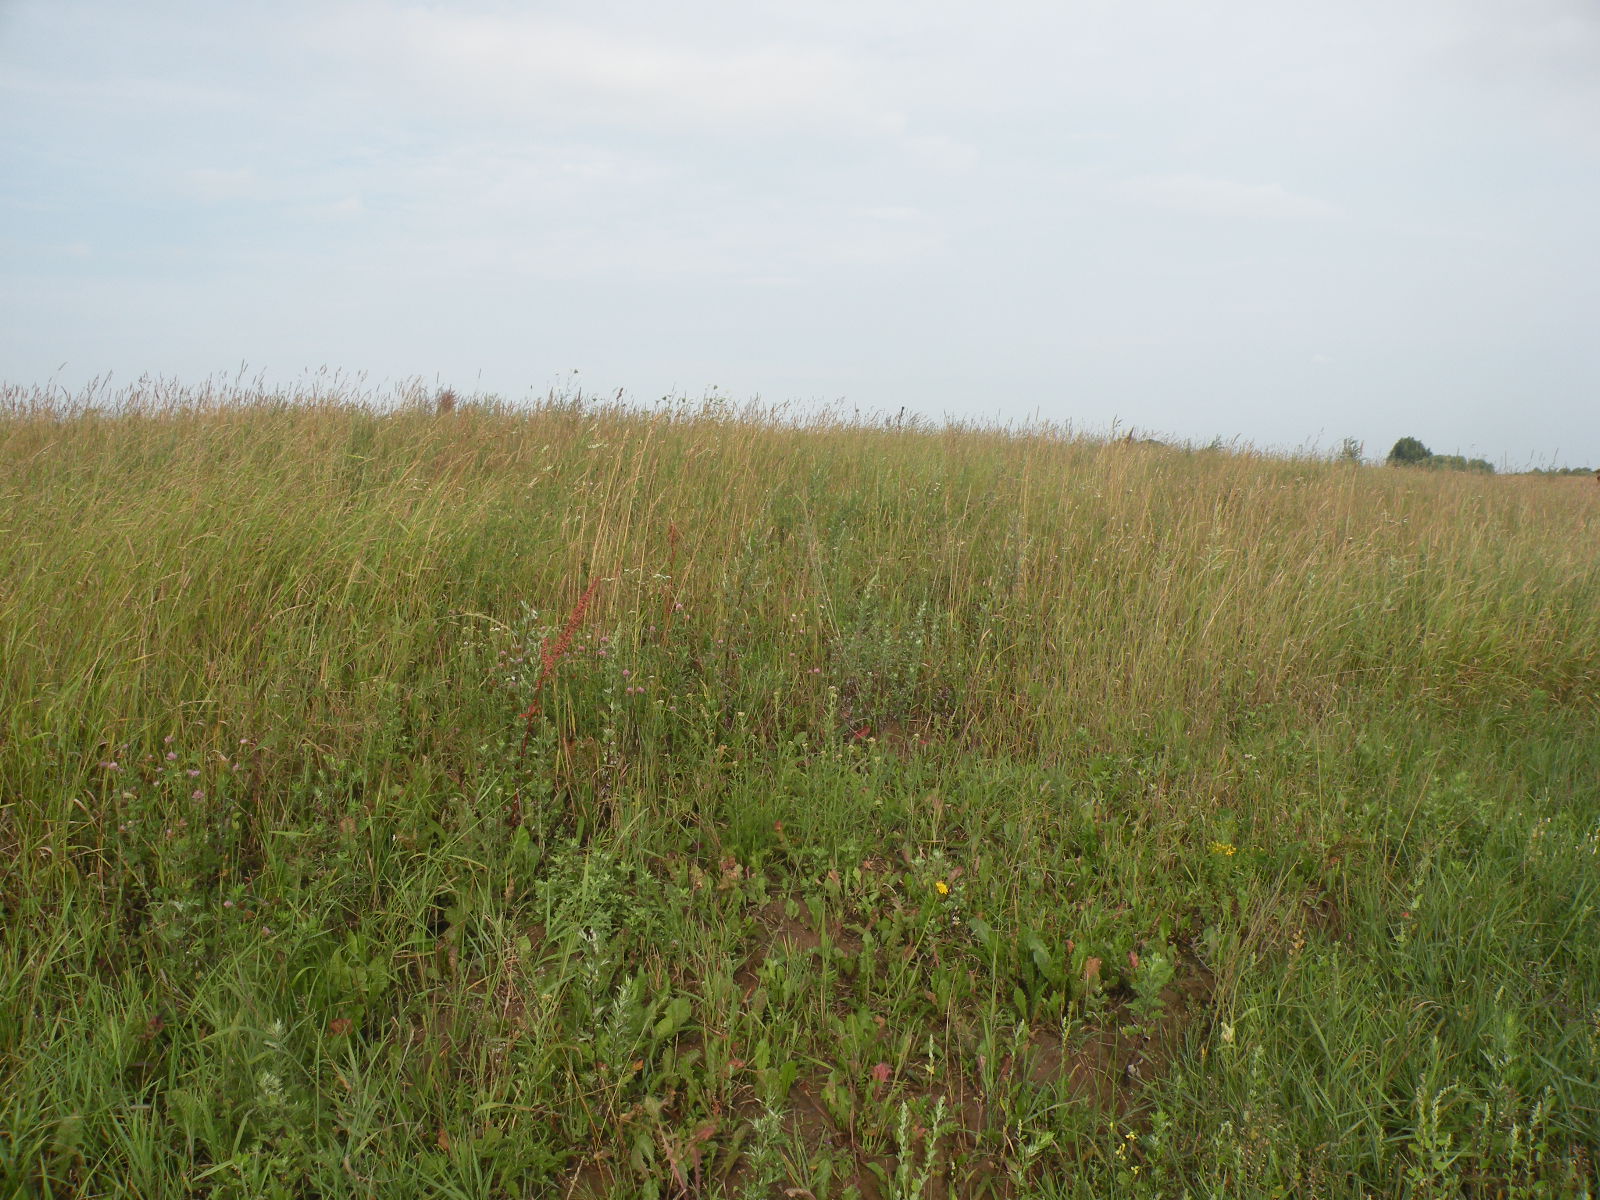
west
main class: Cropland
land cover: Other root crops
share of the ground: 25 - 50 %
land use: Agriculture (excluding fallow land and kitchen gardens)
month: July
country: LV
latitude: 55.8601
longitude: 26.6597
